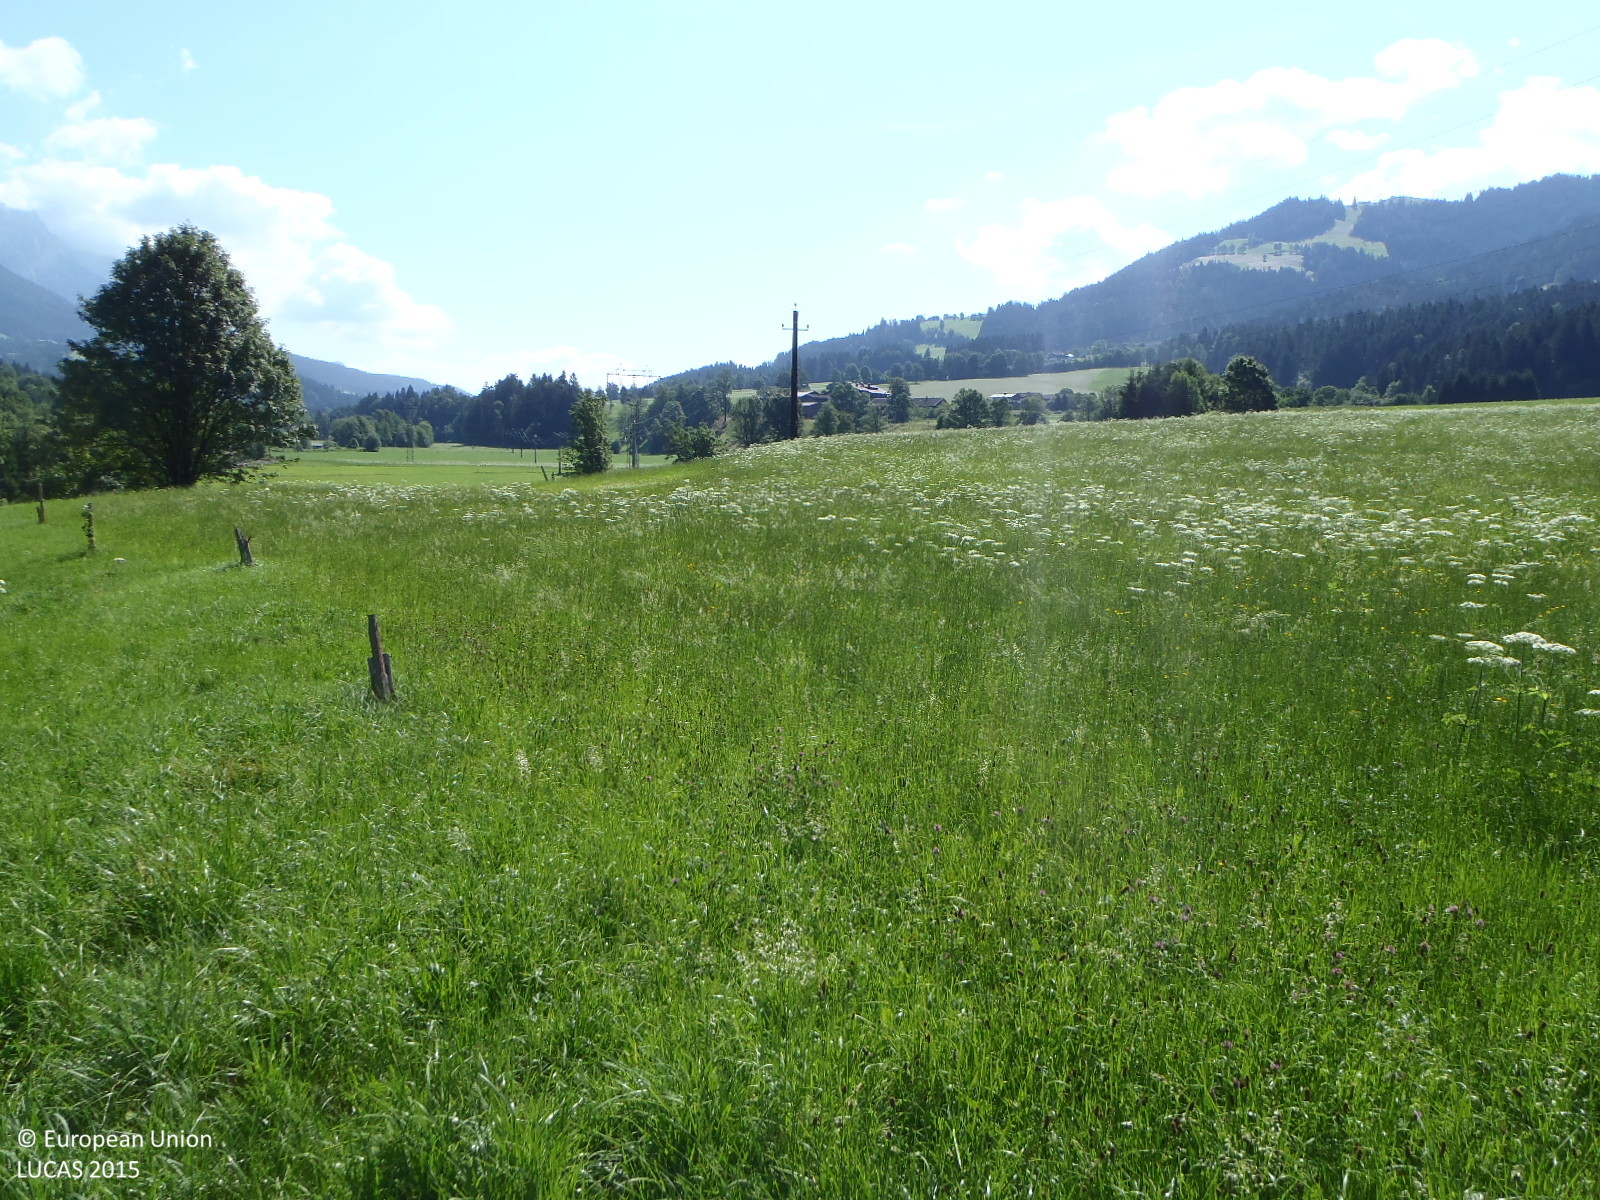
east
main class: Grassland
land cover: Grassland without tree/shrub cover
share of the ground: > 75 %
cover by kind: herbaceous plants 100 %
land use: Agriculture (excluding fallow land and kitchen gardens)
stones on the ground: < 10 %
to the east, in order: Grassland without tree/shrub cover; Electric lines; Grassland without tree/shrub cover
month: July
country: AT
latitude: 47.5171
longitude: 12.2161
